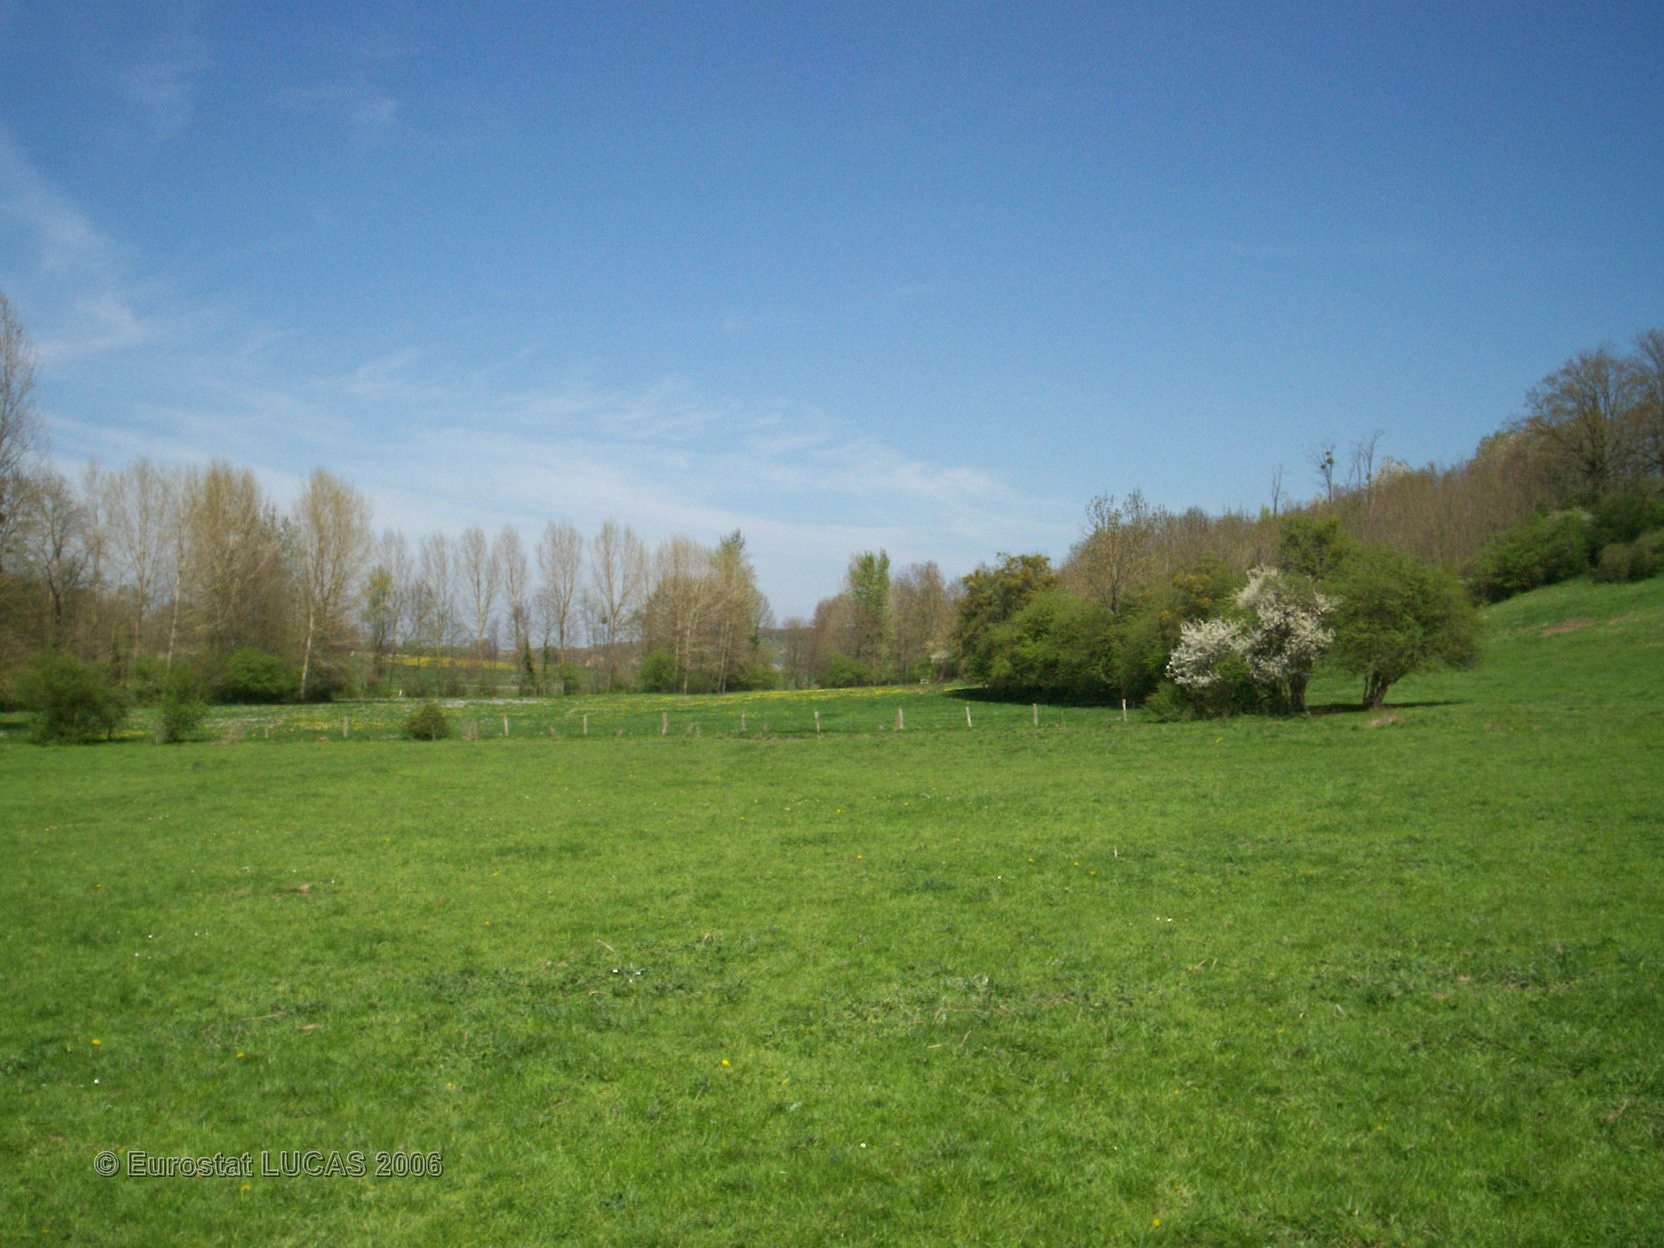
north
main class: Grassland
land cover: Grassland without tree/shrub cover
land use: Agriculture (excluding fallow land and kitchen gardens)
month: April
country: FR
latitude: 49.6466
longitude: 4.3312
